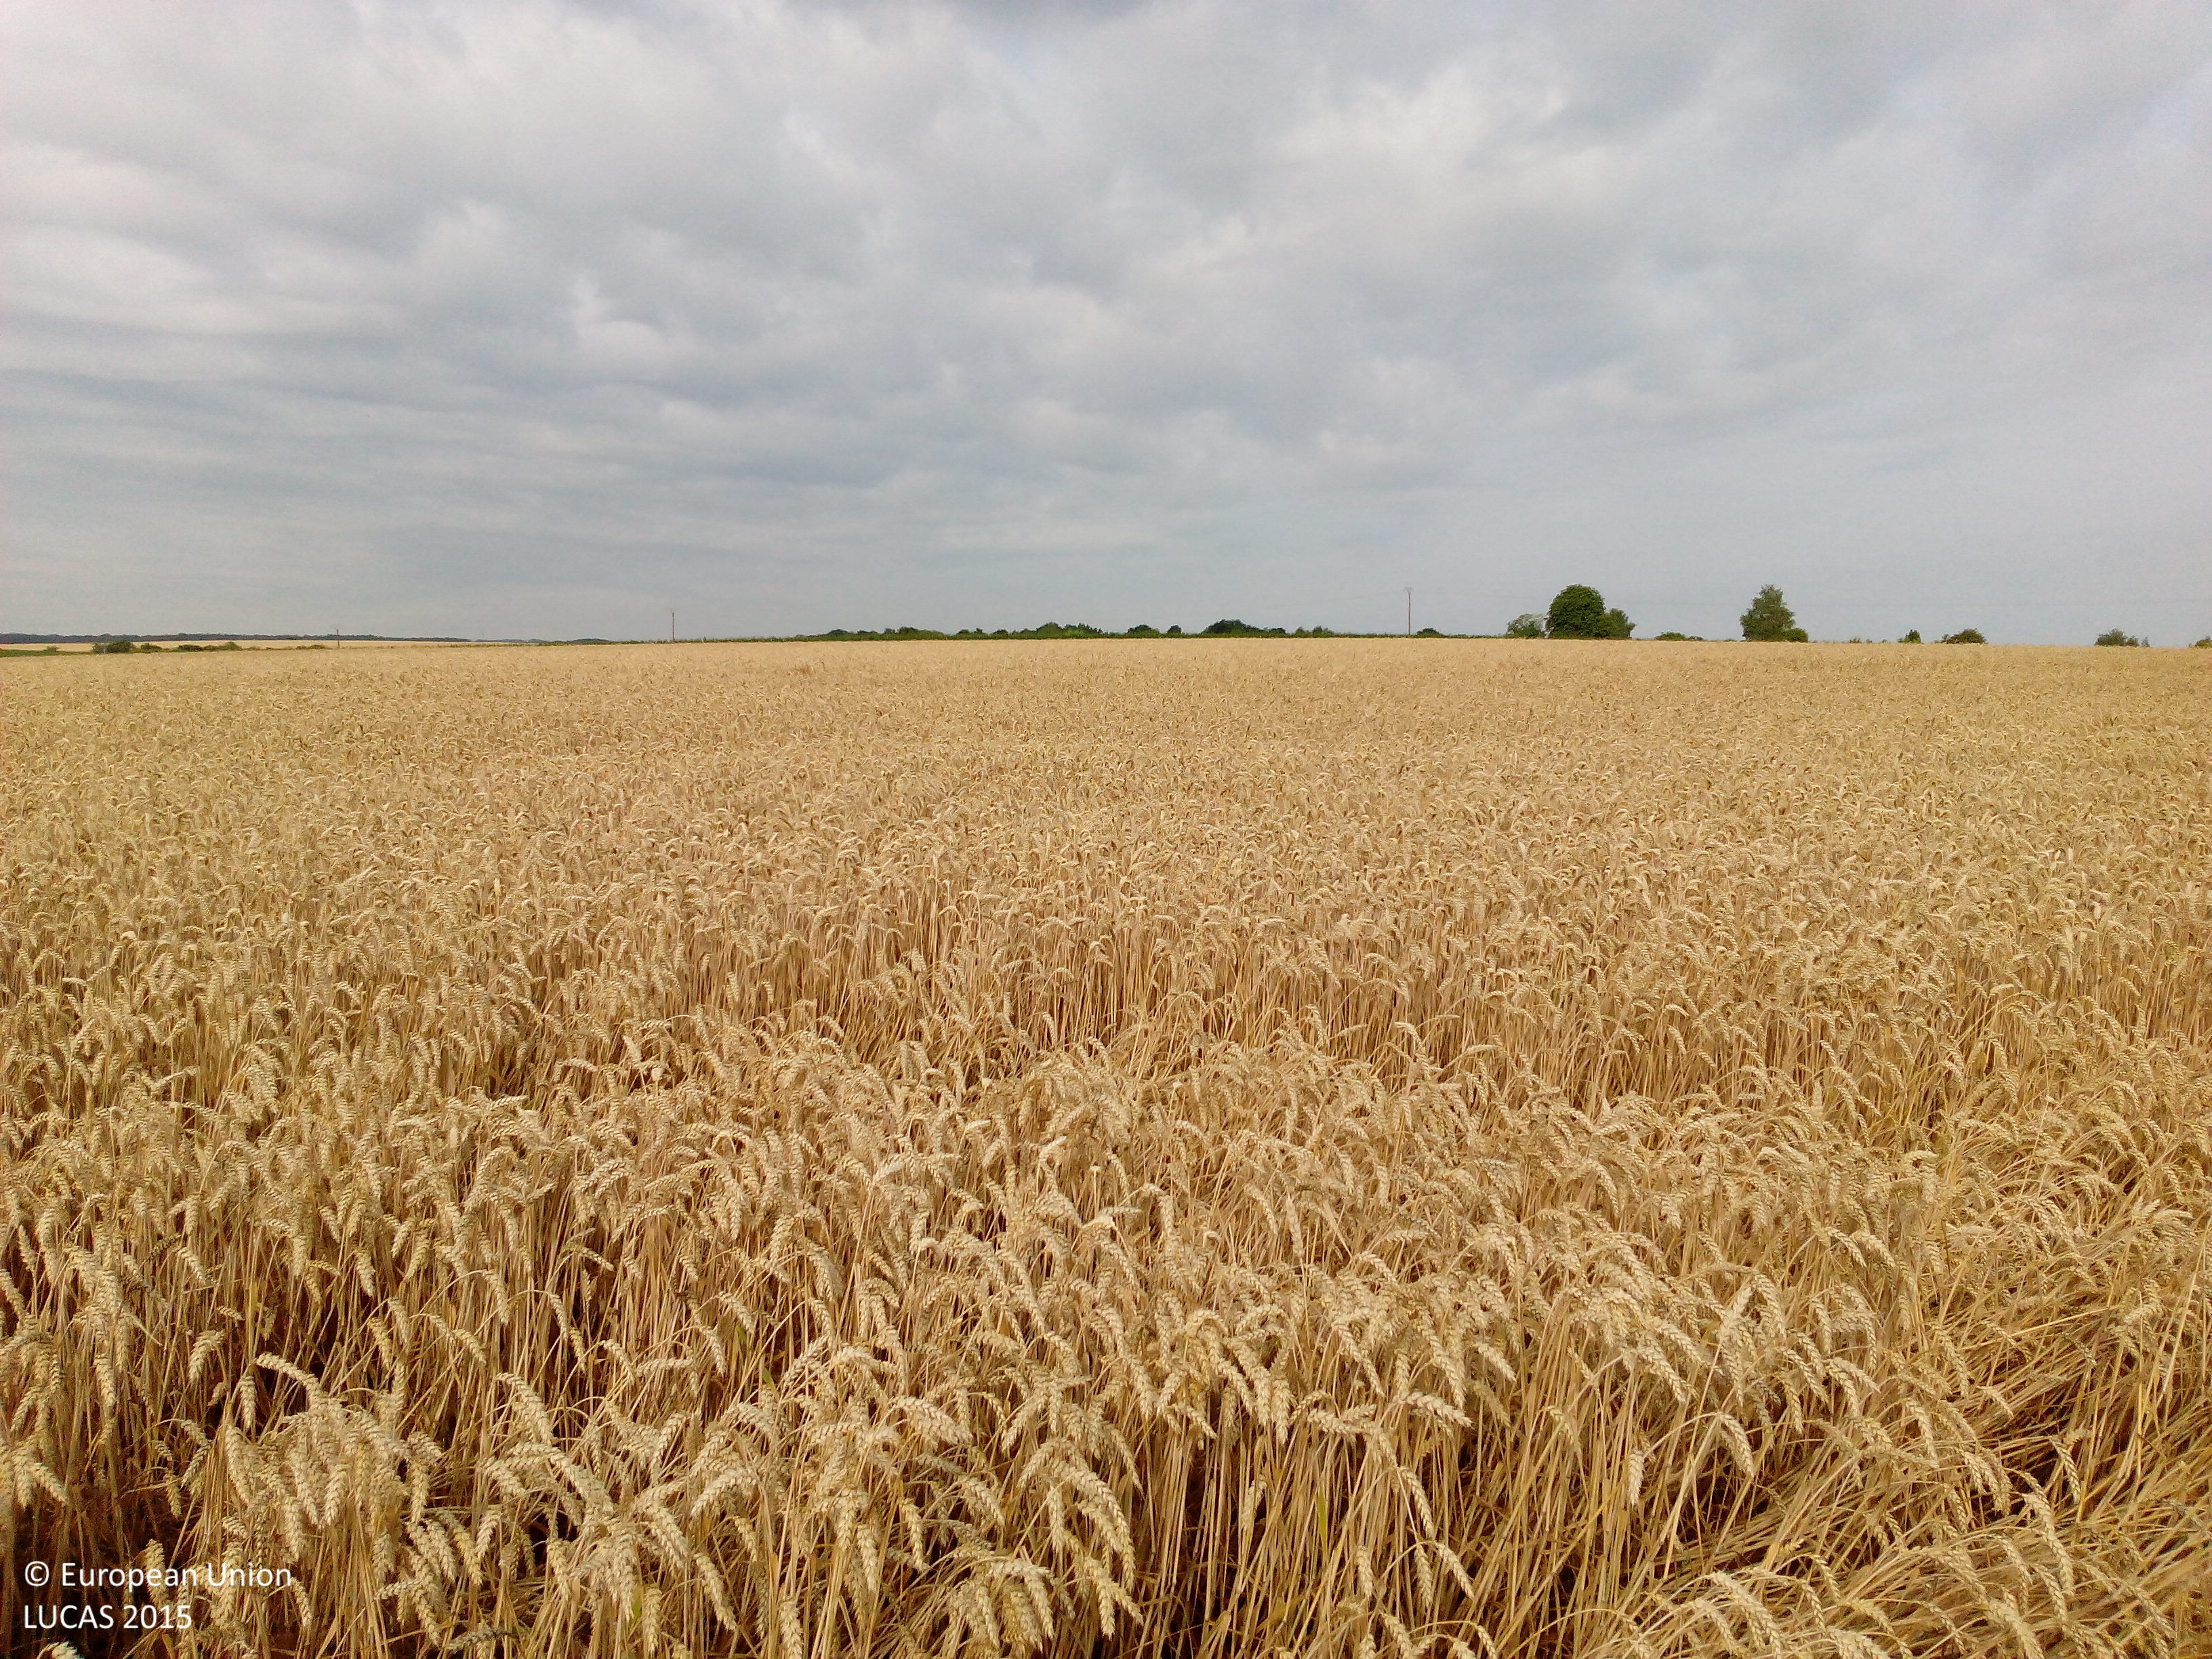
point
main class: Cropland
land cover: Common wheat
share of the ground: > 75 %
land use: Agriculture (excluding fallow land and kitchen gardens)
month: July
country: DE
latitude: 51.5146
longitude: 9.8704
